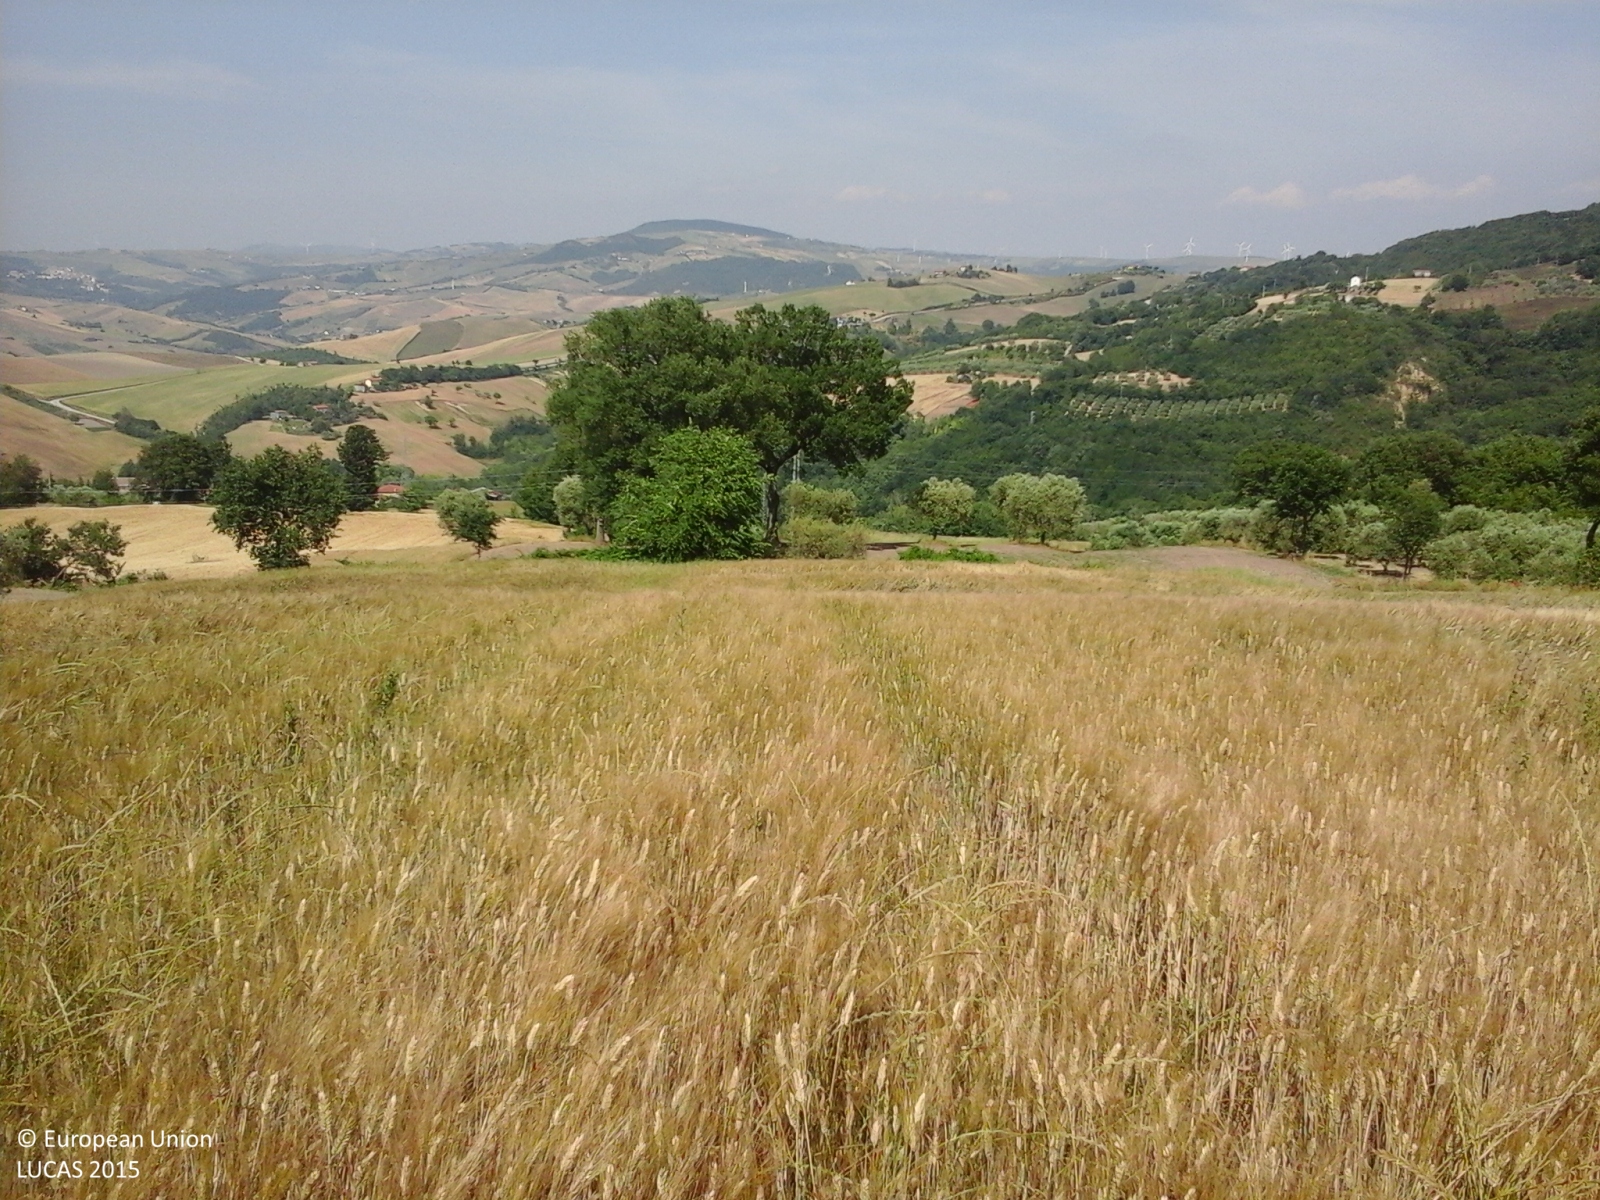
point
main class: Cropland
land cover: Durum wheat
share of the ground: > 75 %
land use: Agriculture (excluding fallow land and kitchen gardens)
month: June
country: IT
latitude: 41.0742
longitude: 15.1581
